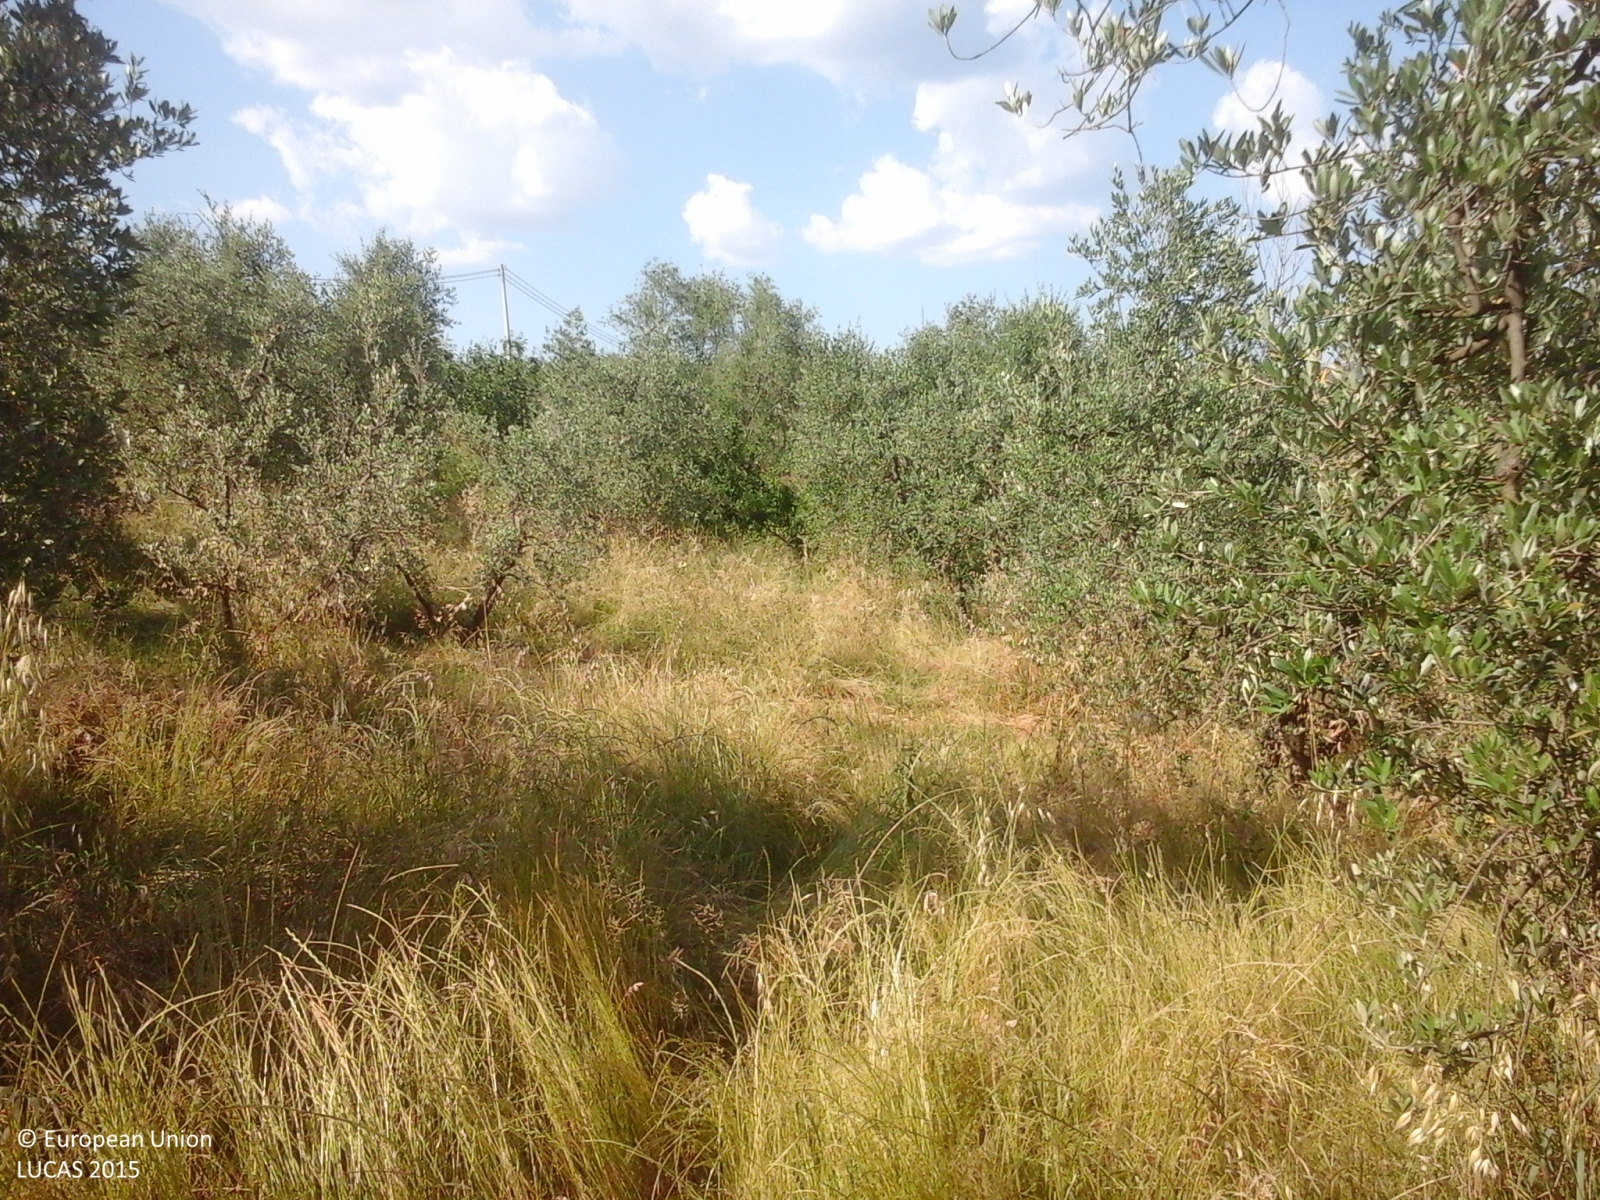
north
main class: Cropland
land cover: Olive groves
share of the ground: 50 - 75 %
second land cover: Grassland without tree/shrub cover
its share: > 75 %
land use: Agriculture (excluding fallow land and kitchen gardens)
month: June
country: IT
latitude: 43.7508
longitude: 10.9537
